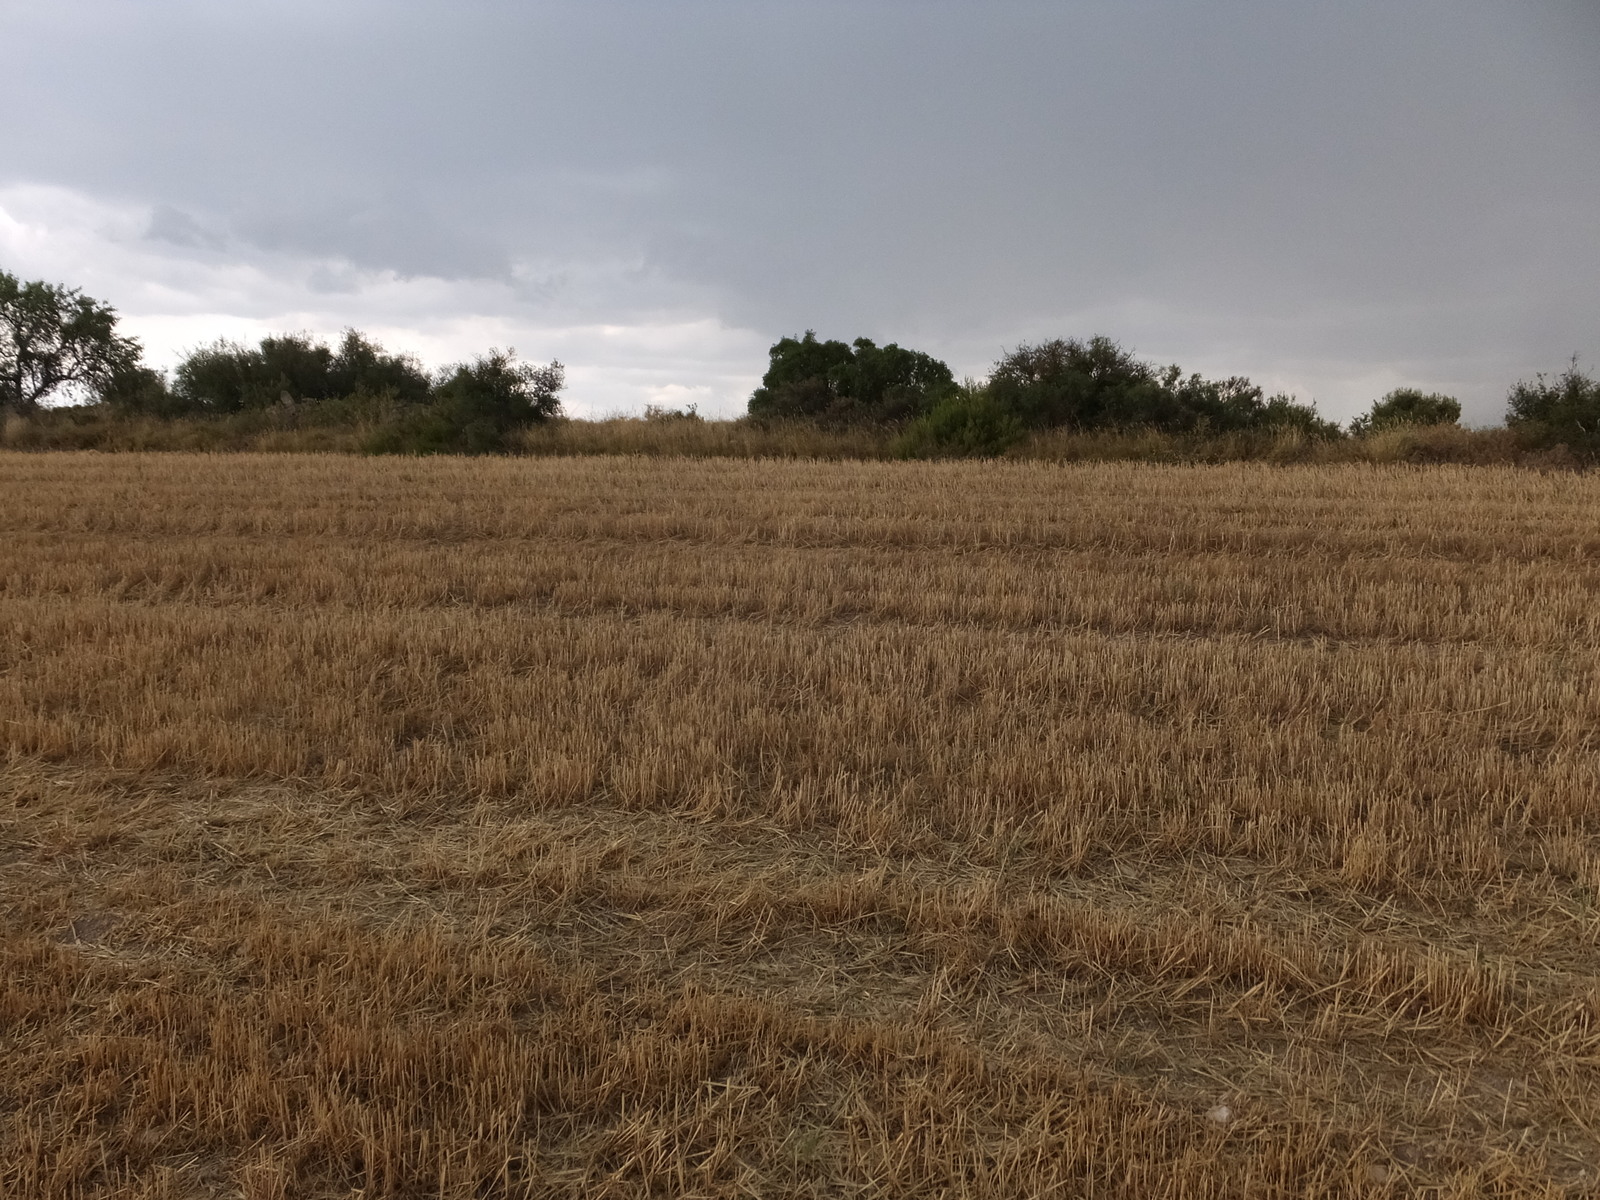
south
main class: Cropland
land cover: Barley
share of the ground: < 10 %
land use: Agriculture (excluding fallow land and kitchen gardens)
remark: Harvested field
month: June
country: ES
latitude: 41.4222
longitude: 0.2839
